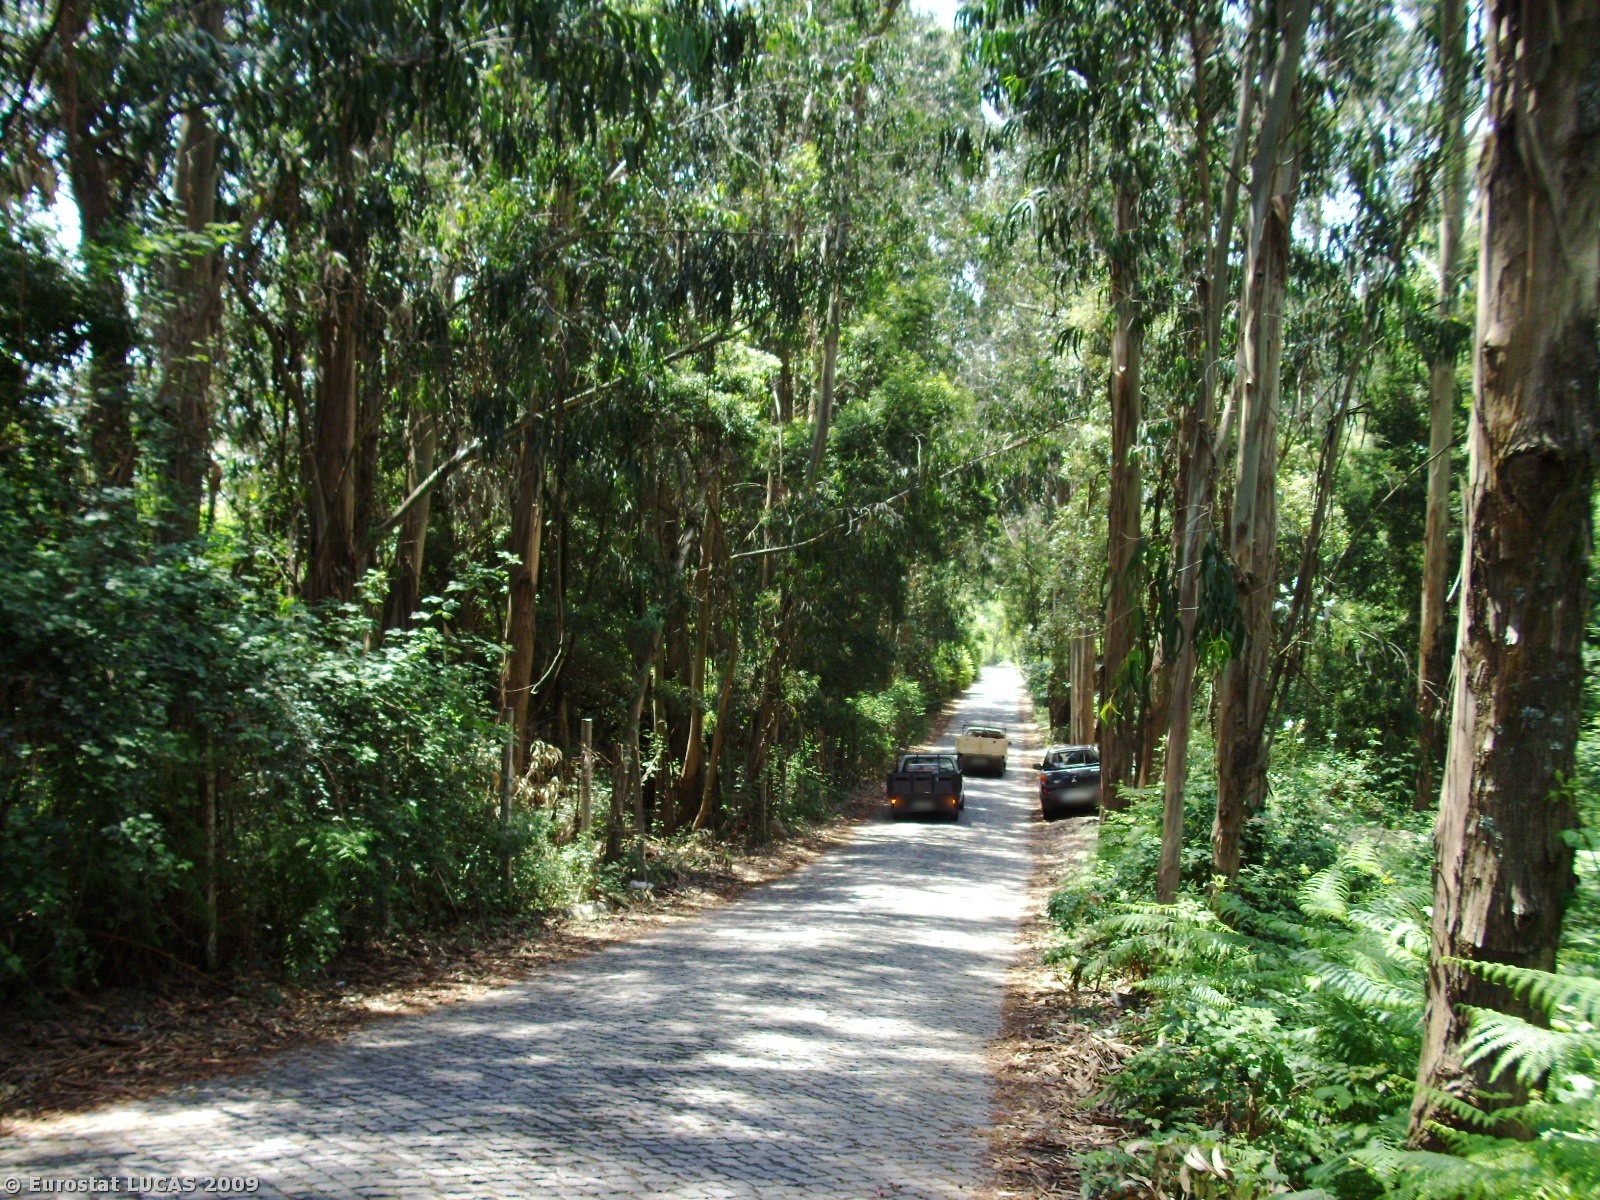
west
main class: Woodland
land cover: Broadleaved woodland
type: plantations and self-sown exotic forest
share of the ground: > 75 %
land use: Forestry
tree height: > 5 m
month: May
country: PT
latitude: 41.0816
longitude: -8.5888
